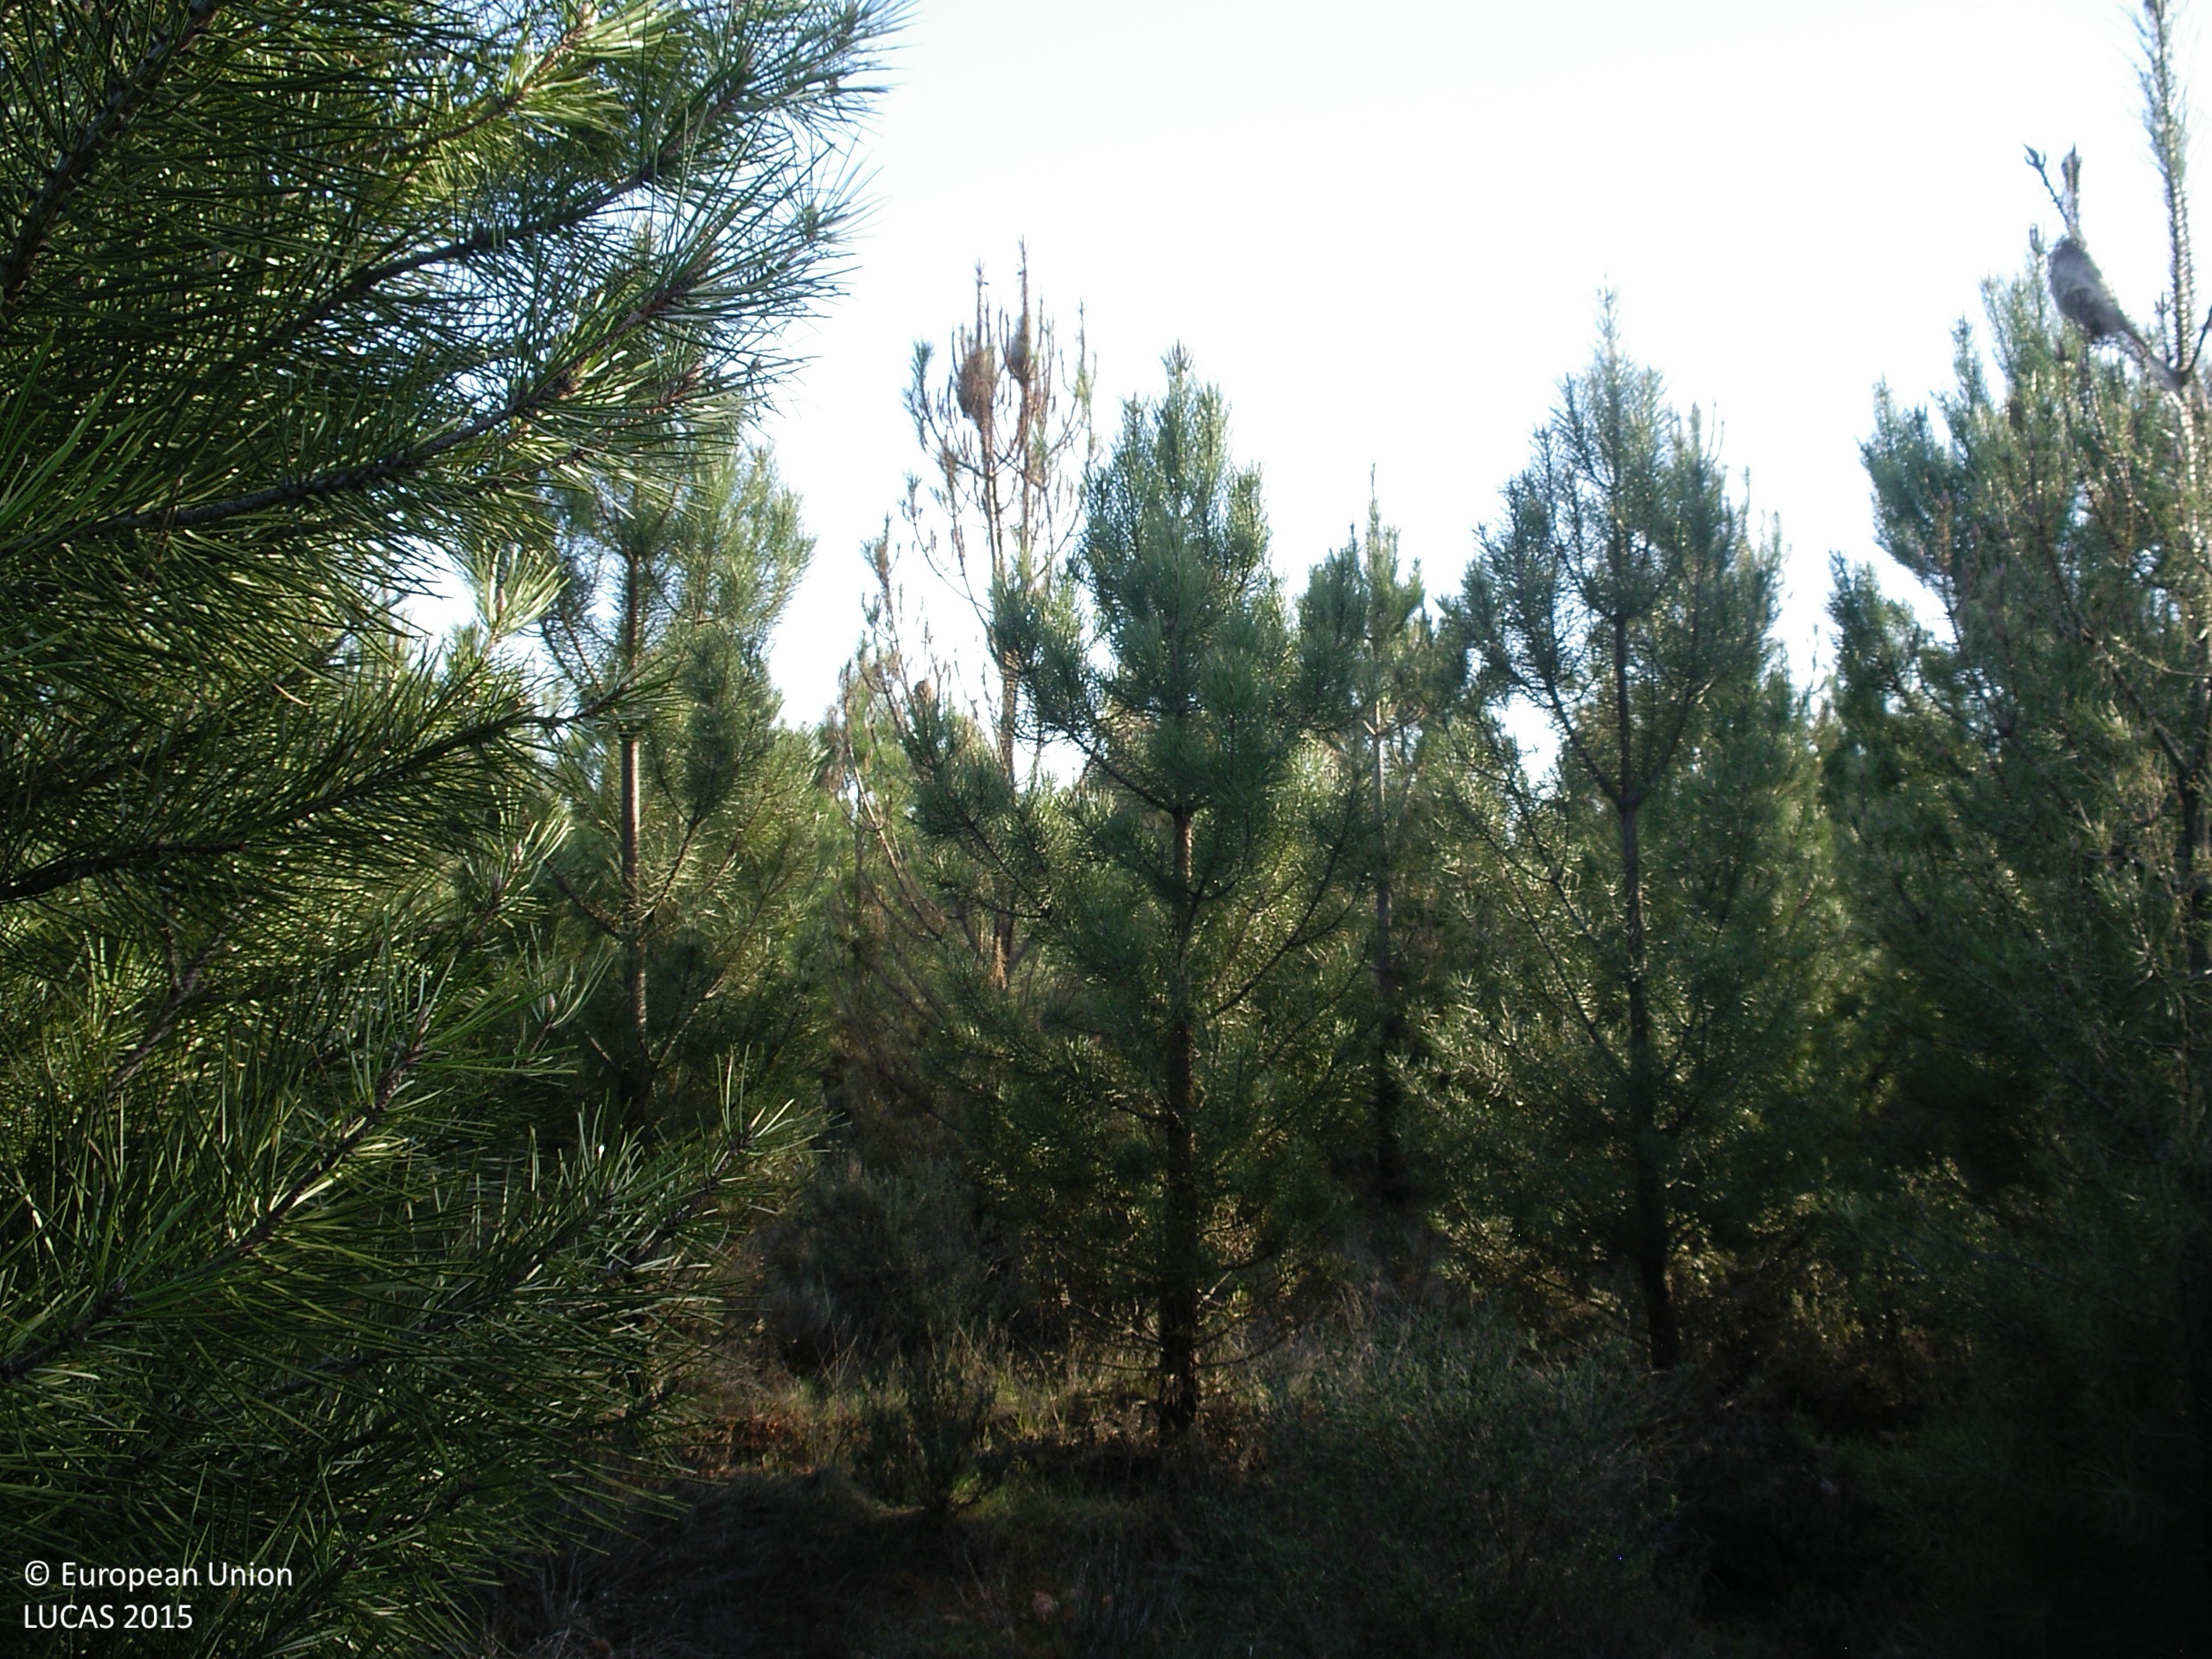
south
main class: Woodland
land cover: Pine dominated coniferous woodland
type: coniferous forest of the mediterranean region
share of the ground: > 75 %
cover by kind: coniferous forest trees 90 %, shrubs 10 %
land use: Forestry
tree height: > 5 m
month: March
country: ES
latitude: 42.2969
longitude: -6.0786
